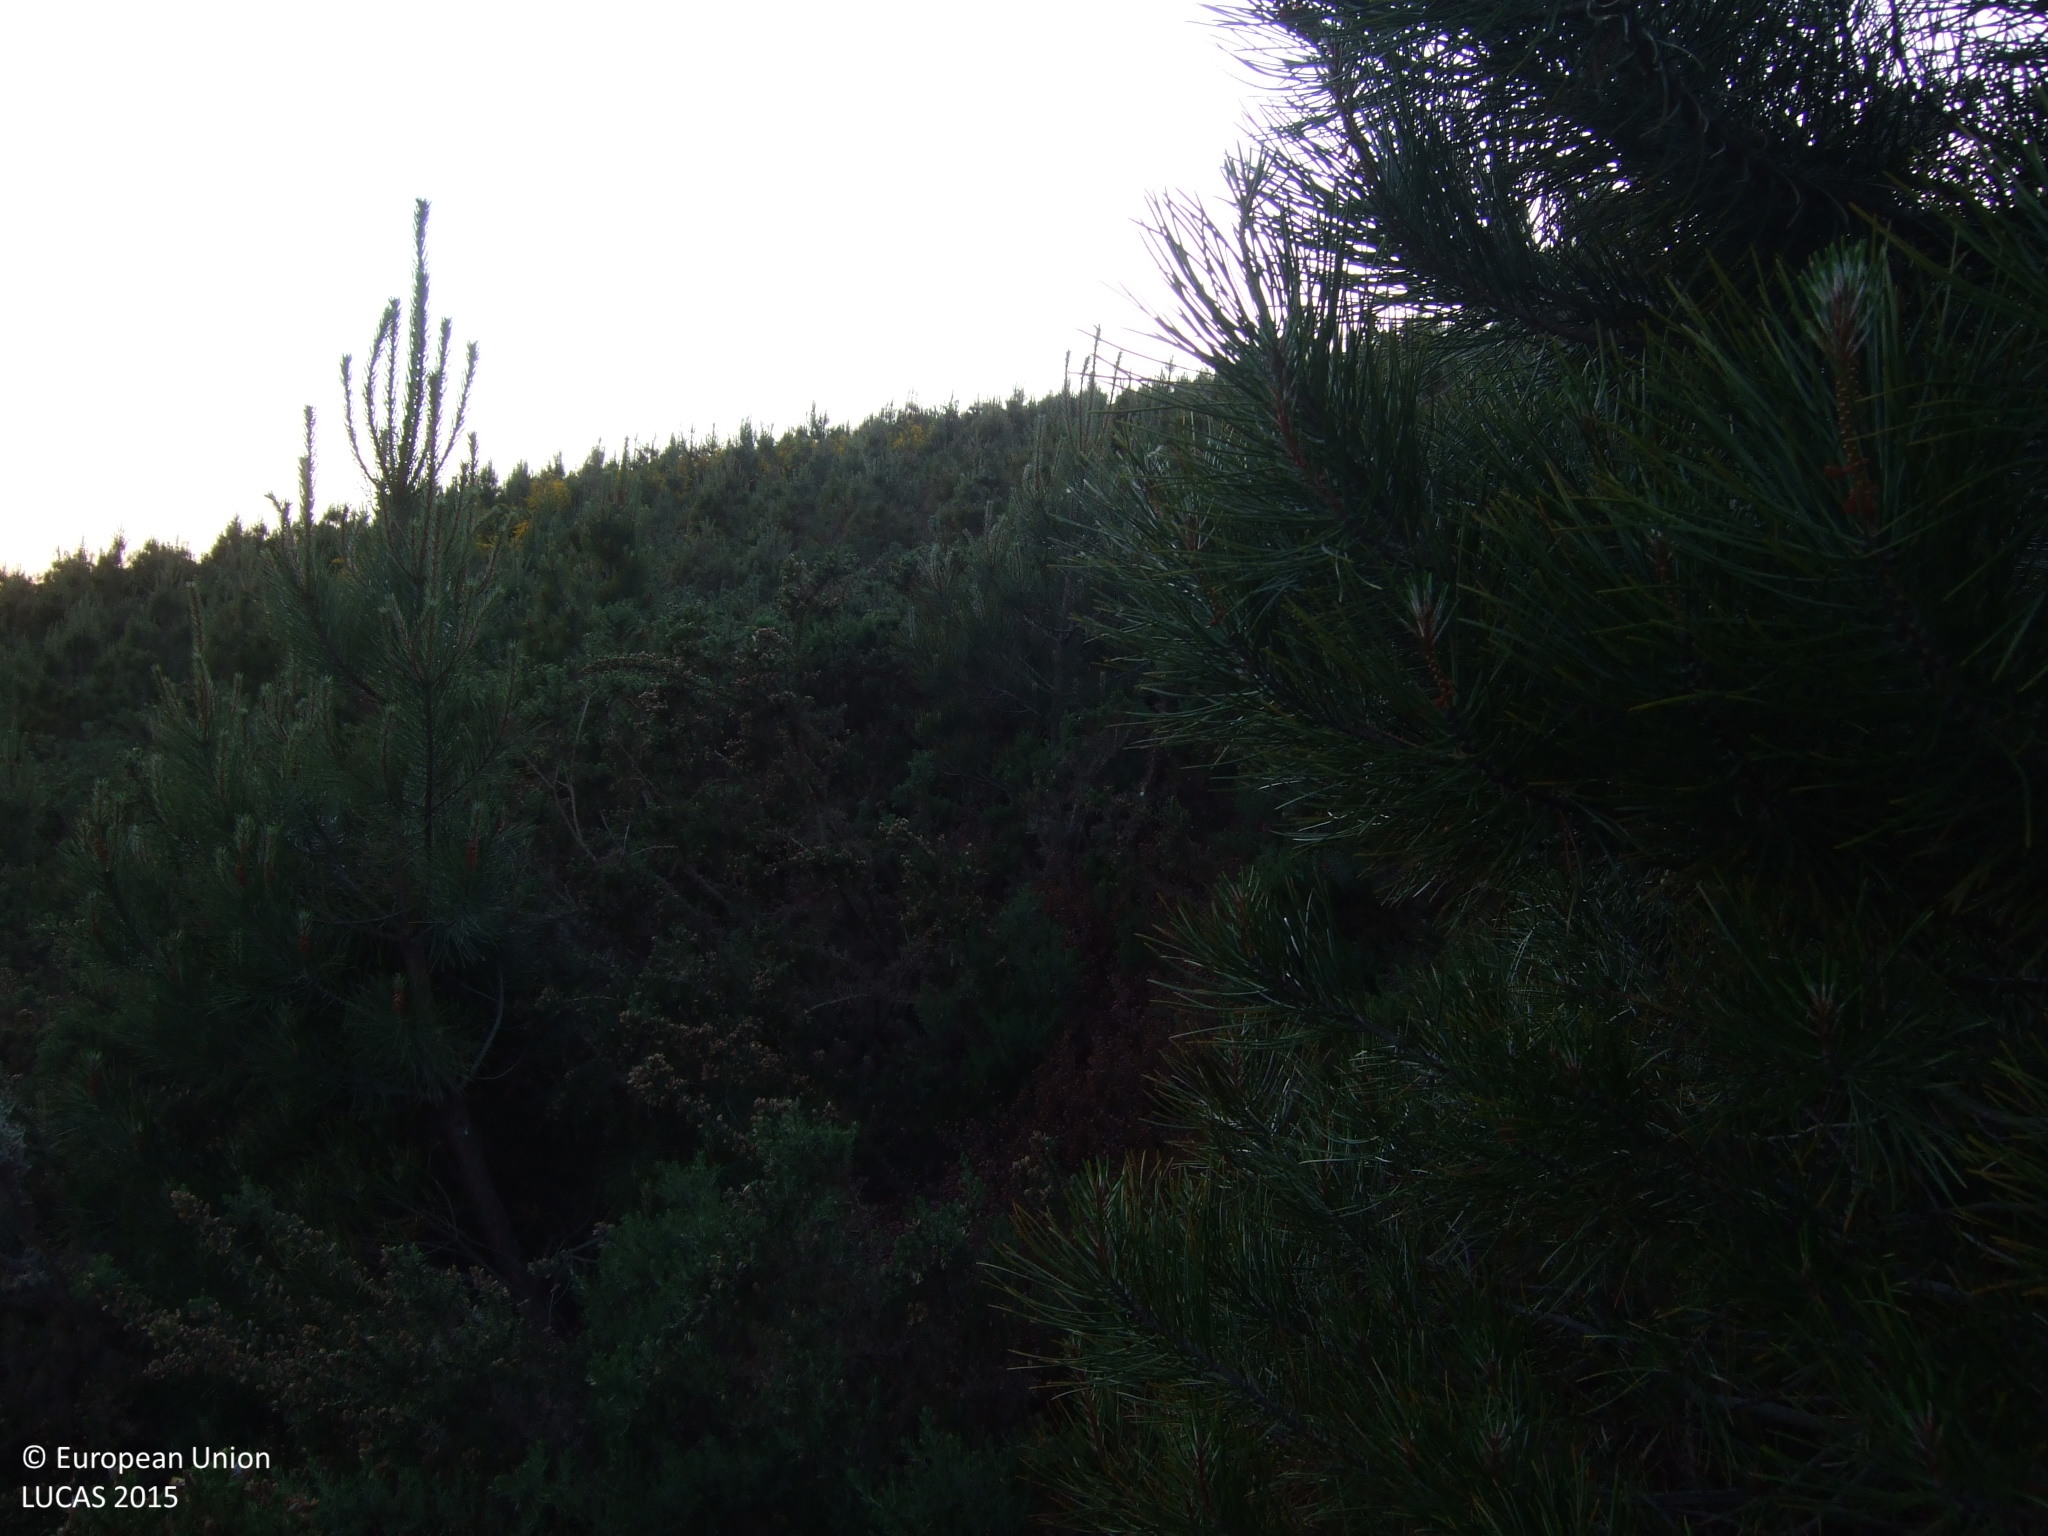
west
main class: Woodland
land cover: Pine dominated coniferous woodland
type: exotic forest
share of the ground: 10 - 25 %
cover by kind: shrubs 80 %, coniferous forest trees 20 %
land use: Forestry
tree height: < 5 m
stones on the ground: > 50 %
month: May
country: ES
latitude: 42.7146
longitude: -7.3203
